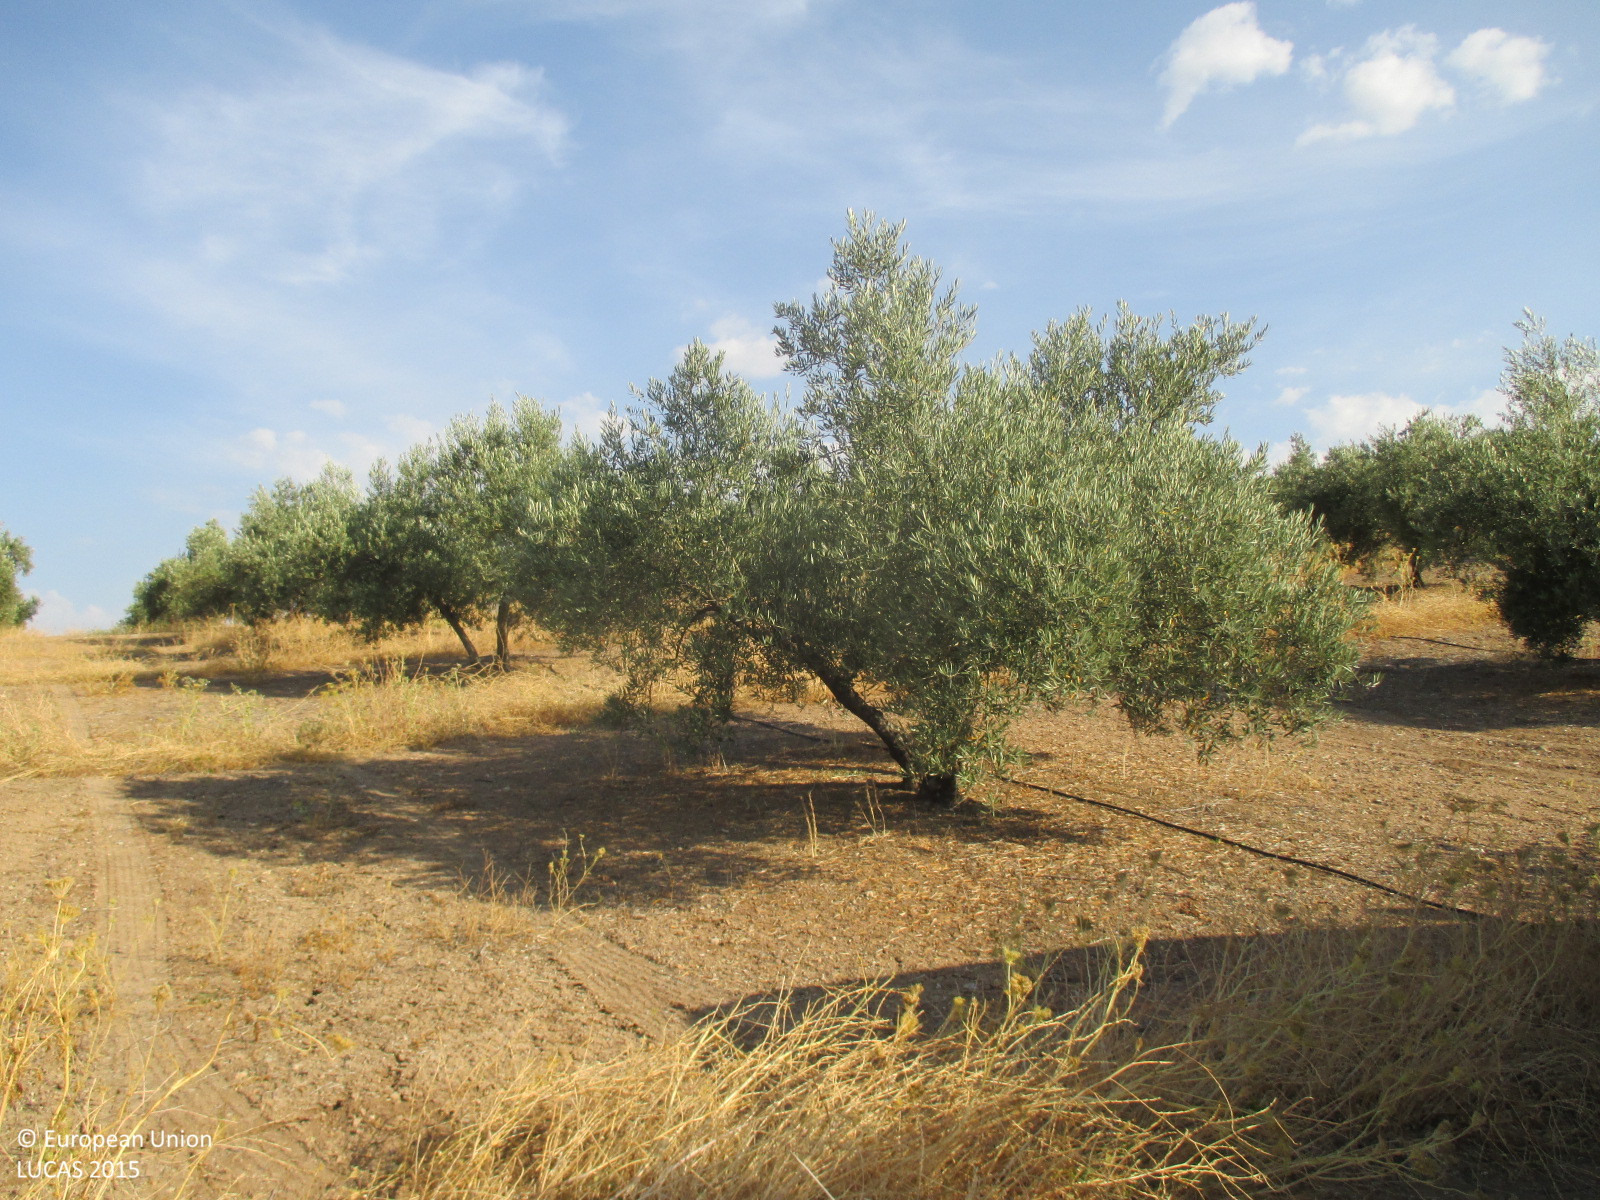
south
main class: Cropland
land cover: Olive groves
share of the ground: 25 - 50 %
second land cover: Other bare soil
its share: > 75 %
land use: Agriculture (excluding fallow land and kitchen gardens)
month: June
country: ES
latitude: 37.6237
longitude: -4.1308
